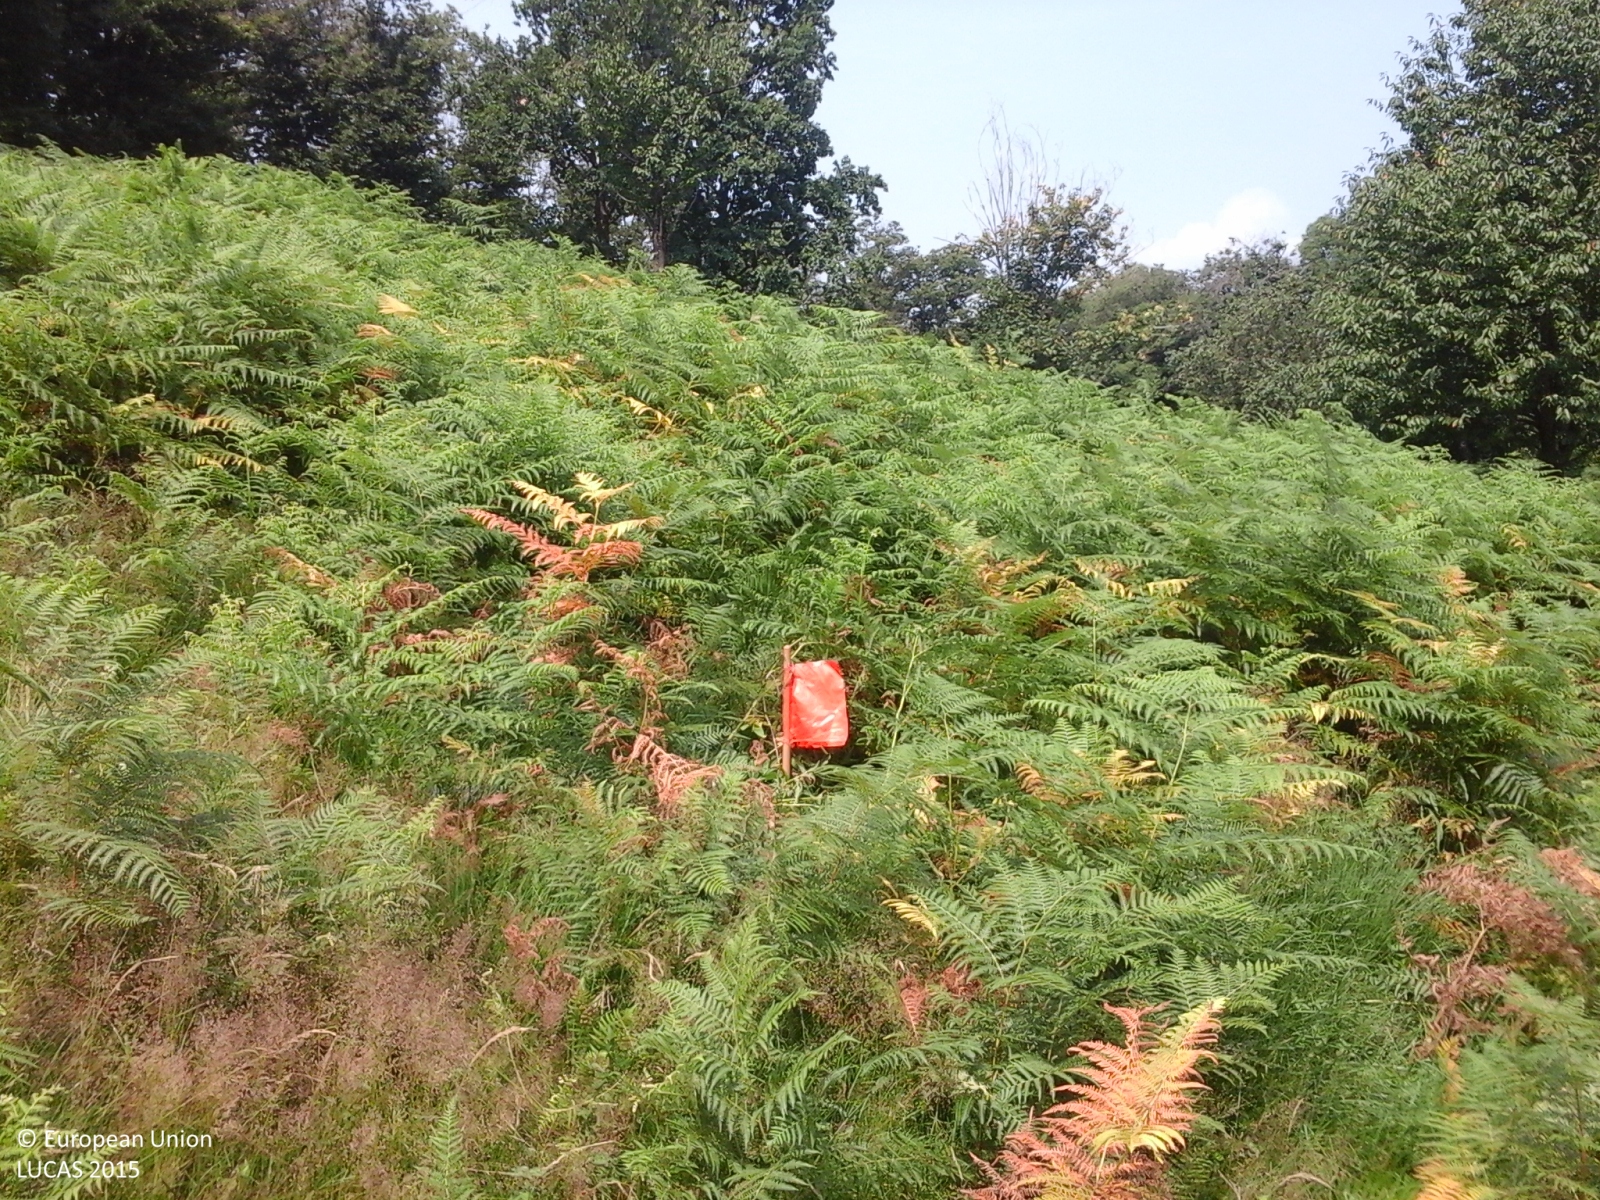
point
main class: Grassland
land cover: Grassland with sparse tree/shrub cover
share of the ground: > 75 %
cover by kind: herbaceous plants 95 %, broadleaved forest trees 5 %
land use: Semi-natural and natural areas not in use
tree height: > 5 m
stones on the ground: < 10 %
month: July
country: IT
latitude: 45.9652
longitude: 8.7243
